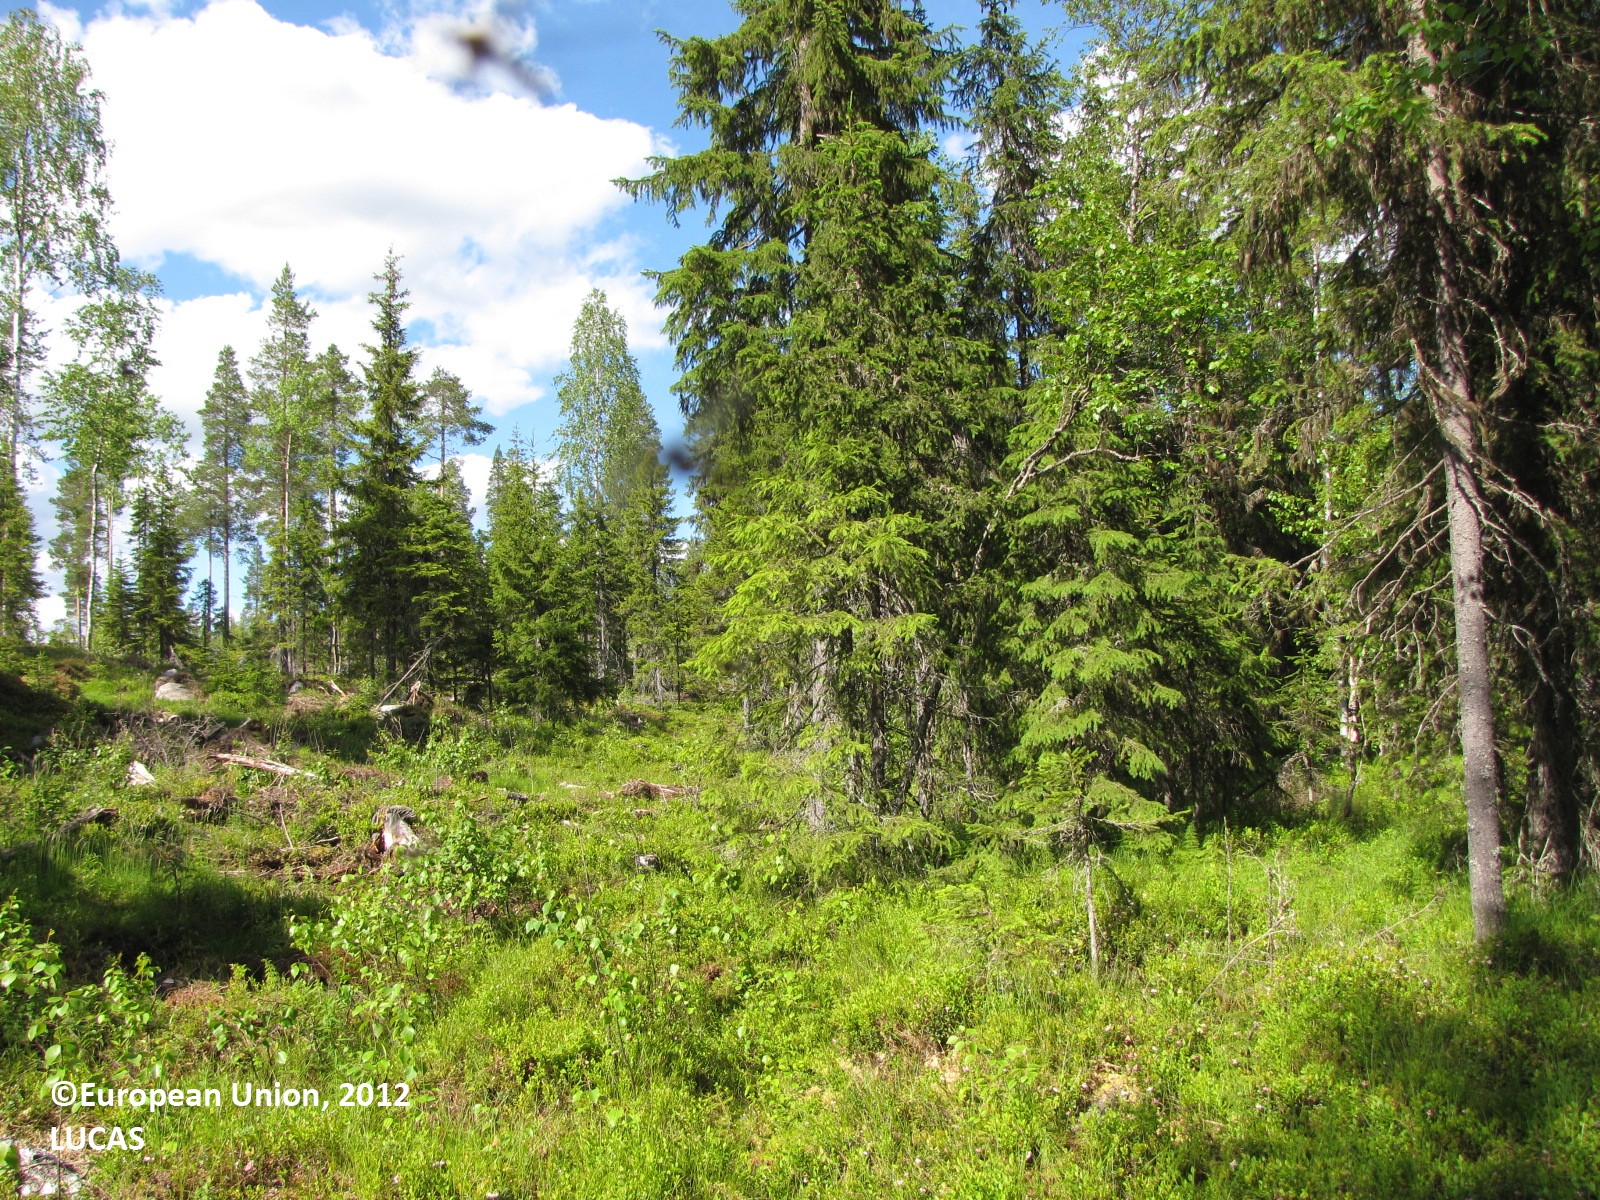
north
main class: Woodland
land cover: Spruce dominated mixed woodland
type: boreal forest
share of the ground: 25 - 50 %
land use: Forestry
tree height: > 5 m
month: July
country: FI
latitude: 66.2435
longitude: 25.2561
